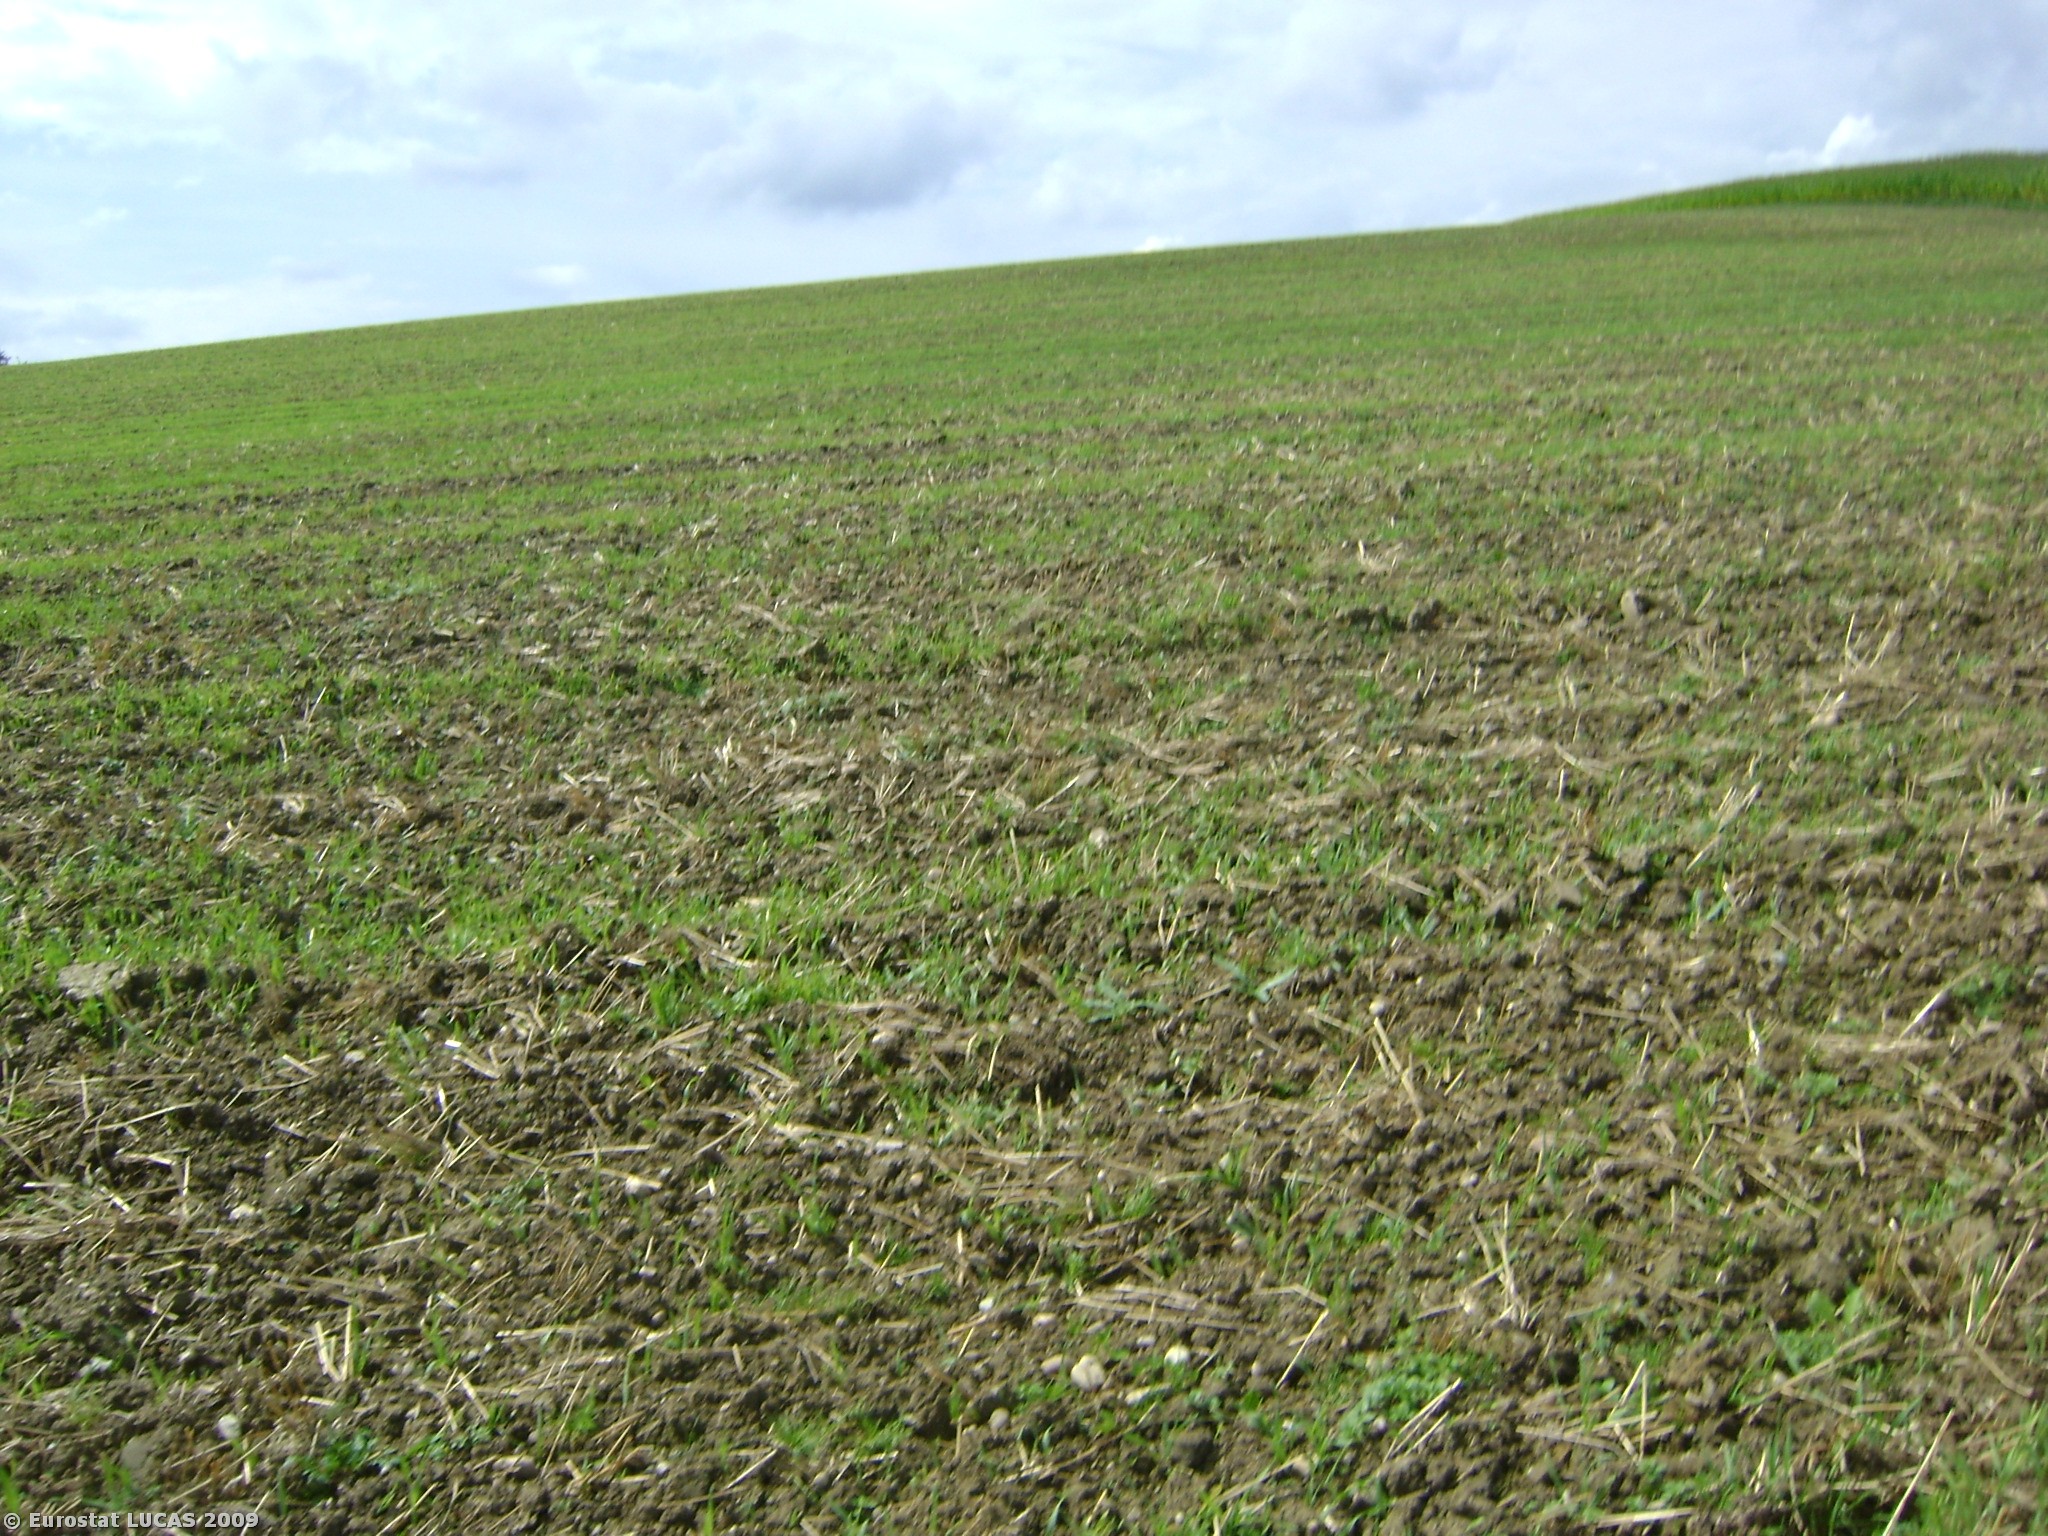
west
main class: Cropland
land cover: Triticale
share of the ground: < 10 %
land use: Agriculture (excluding fallow land and kitchen gardens)
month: August
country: AT
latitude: 48.1669
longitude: 13.5355
